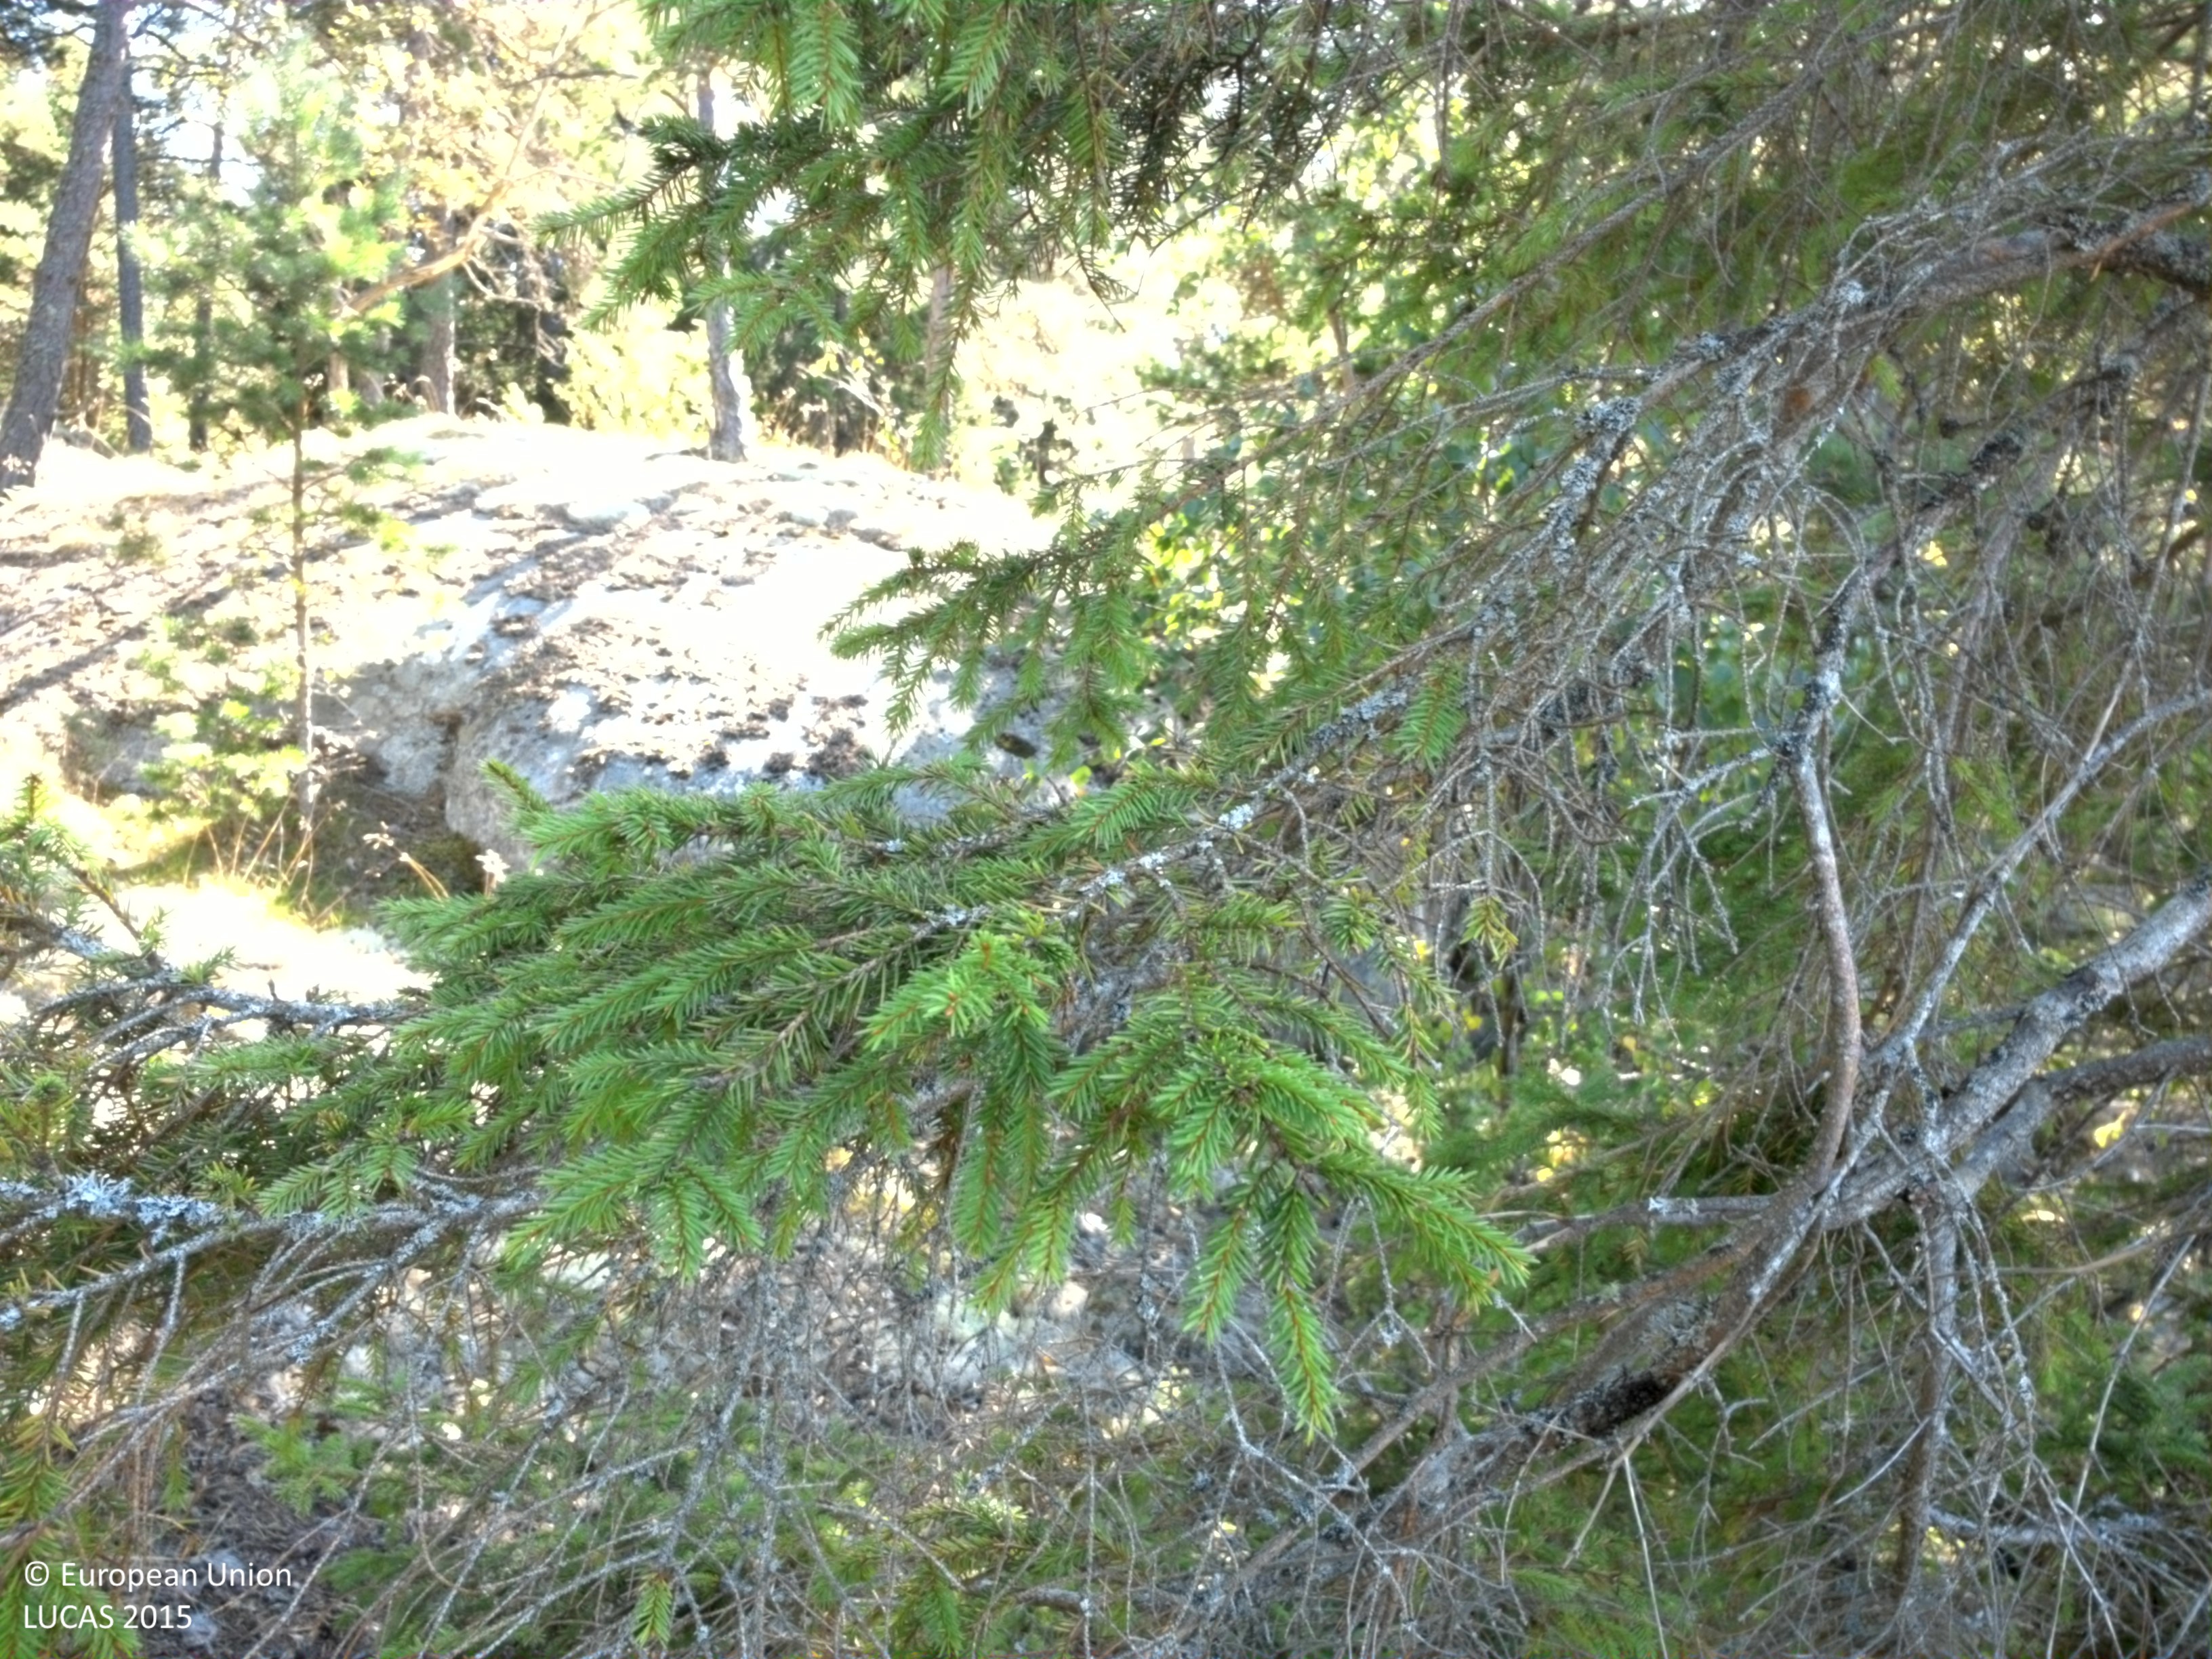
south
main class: Woodland
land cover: Other coniferous woodland
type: boreal forest
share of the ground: 50 - 75 %
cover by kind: coniferous forest trees 45 %, consolidated bare surface 30 %, lichens and mosses 20 %, broadleaved forest trees 5 %
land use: Forestry
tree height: > 5 m
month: August
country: SE
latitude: 59.5969
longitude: 18.8058
